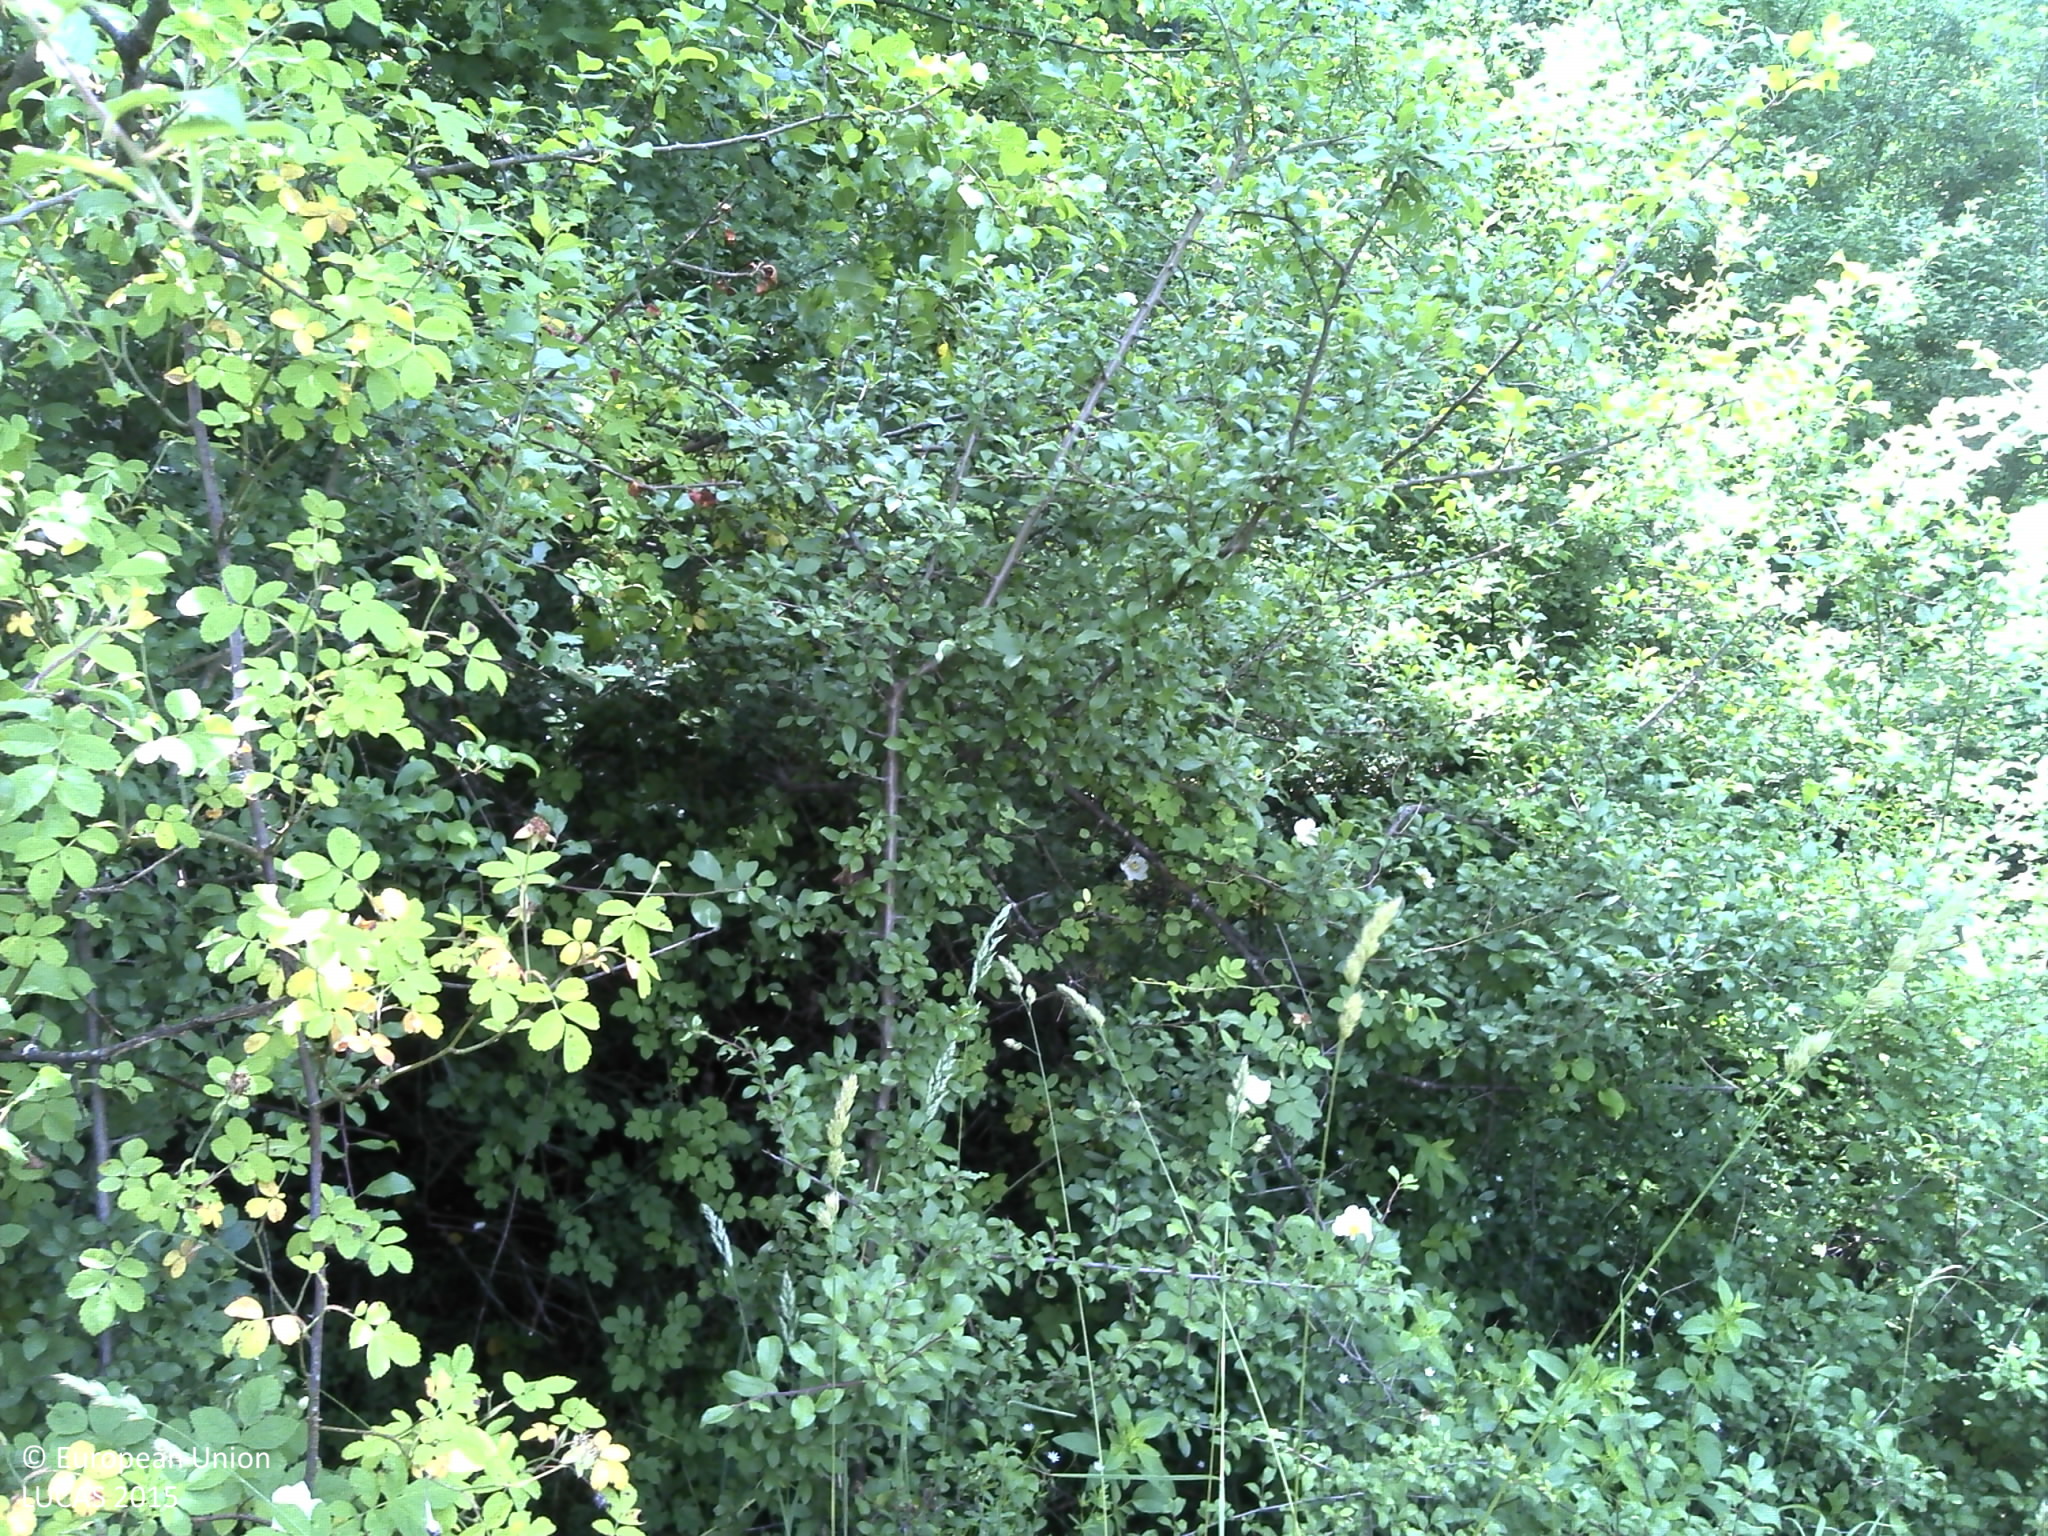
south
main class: Woodland
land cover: Broadleaved woodland
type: beech forest
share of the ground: > 75 %
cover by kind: broadleaved forest trees 95 %, herbaceous plants 5 %
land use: Semi-natural and natural areas not in use
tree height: > 5 m
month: June
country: HR
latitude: 44.5358
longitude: 16.0473
